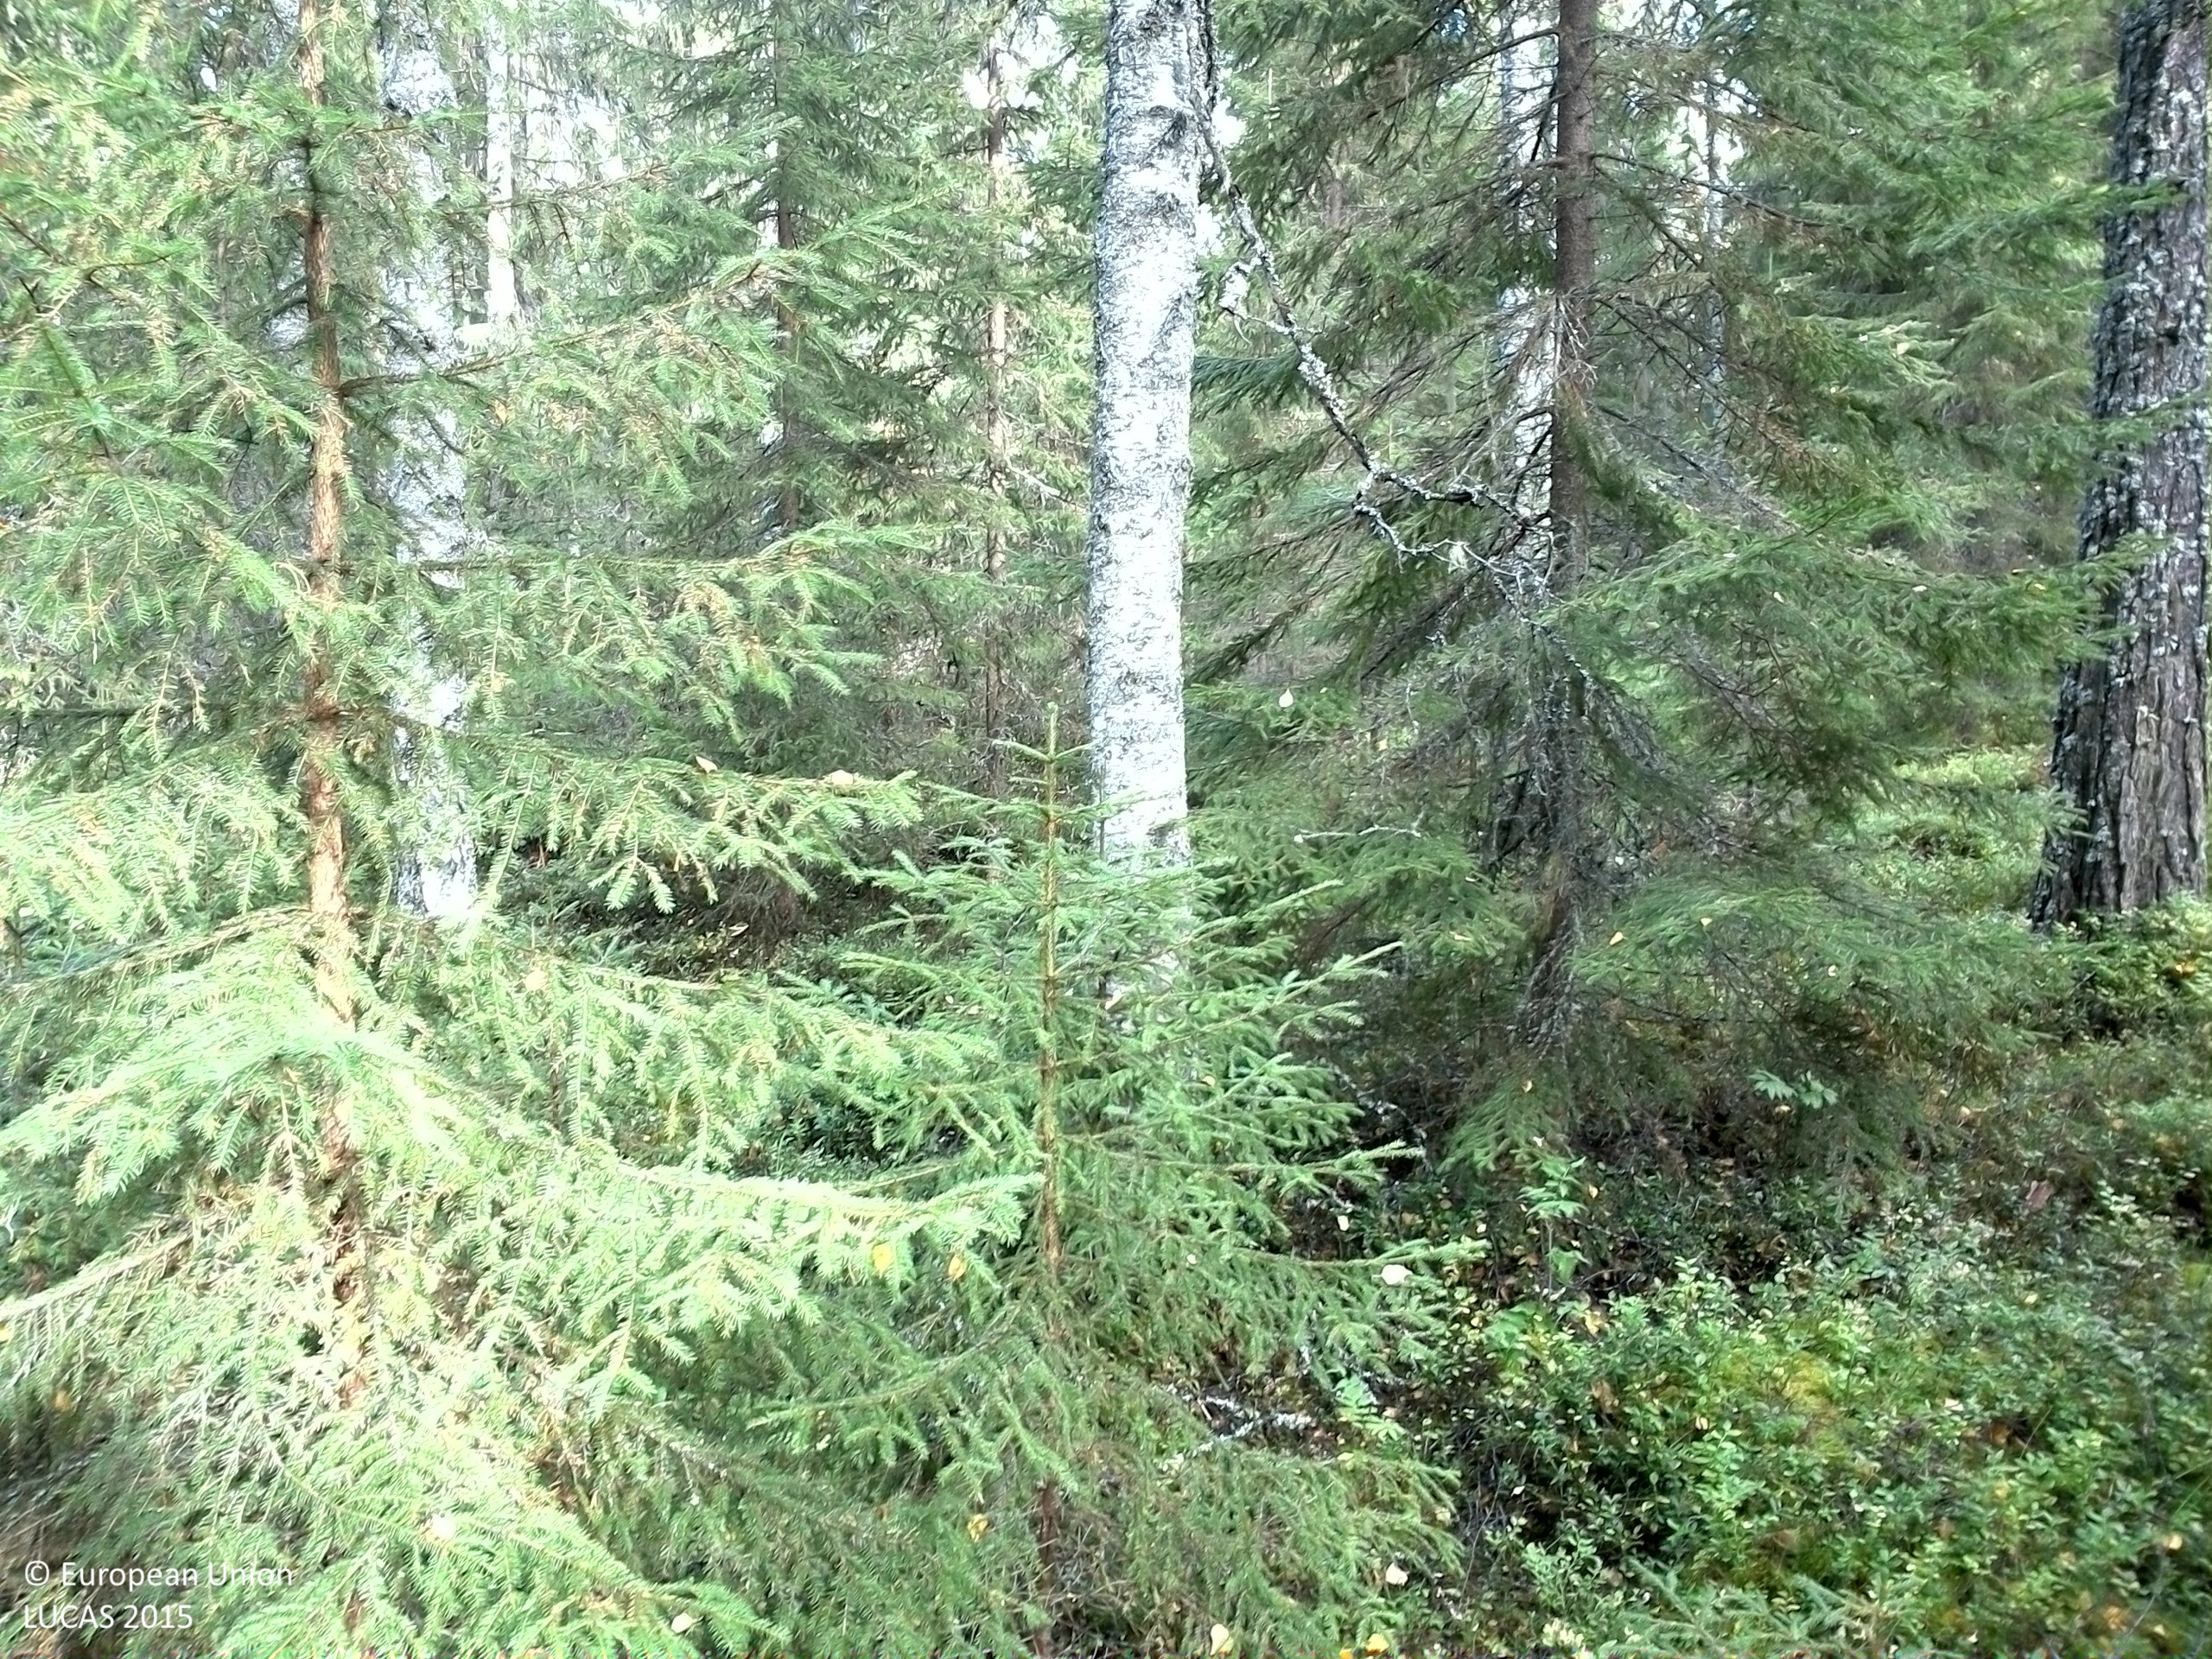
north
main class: Woodland
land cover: Spruce dominated mixed woodland
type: boreal forest
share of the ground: 50 - 75 %
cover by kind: coniferous forest trees 45 %, shrubs 25 %, broadleaved forest trees 15 %, lichens and mosses 15 %
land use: Forestry
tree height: > 5 m
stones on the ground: 10 - 25 %
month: September
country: SE
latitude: 61.3443
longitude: 15.3123
